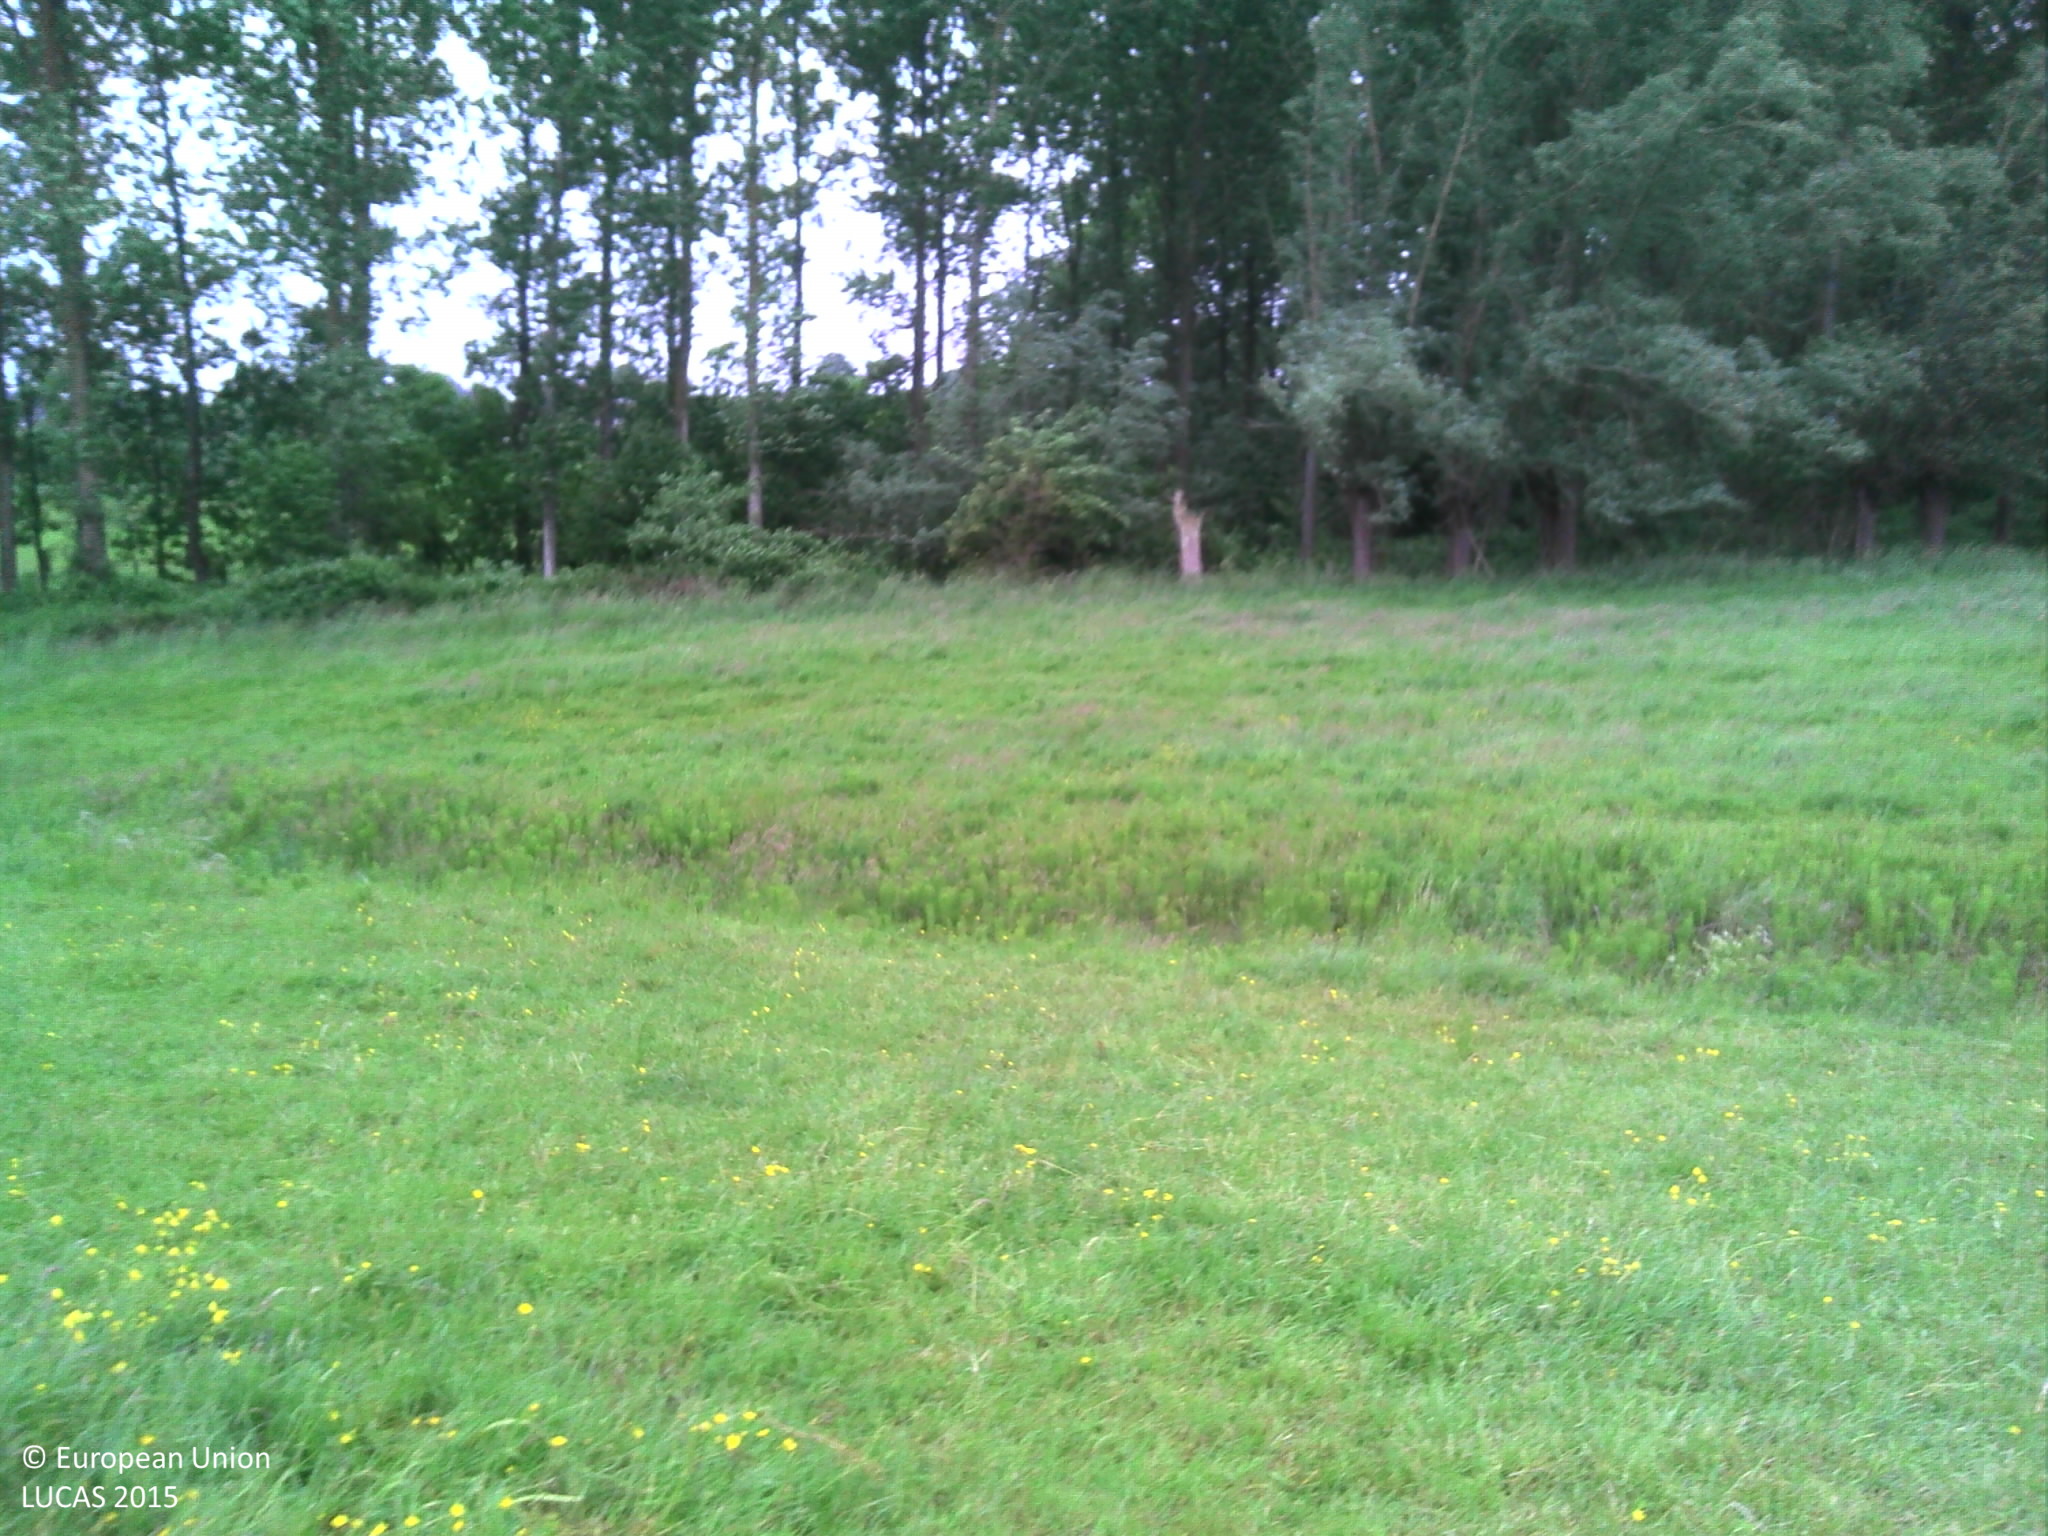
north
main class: Grassland
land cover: Grassland without tree/shrub cover
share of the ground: > 75 %
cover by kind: herbaceous plants 100 %
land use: Agriculture (excluding fallow land and kitchen gardens)
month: June
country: BE
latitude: 50.8265
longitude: 3.7894
